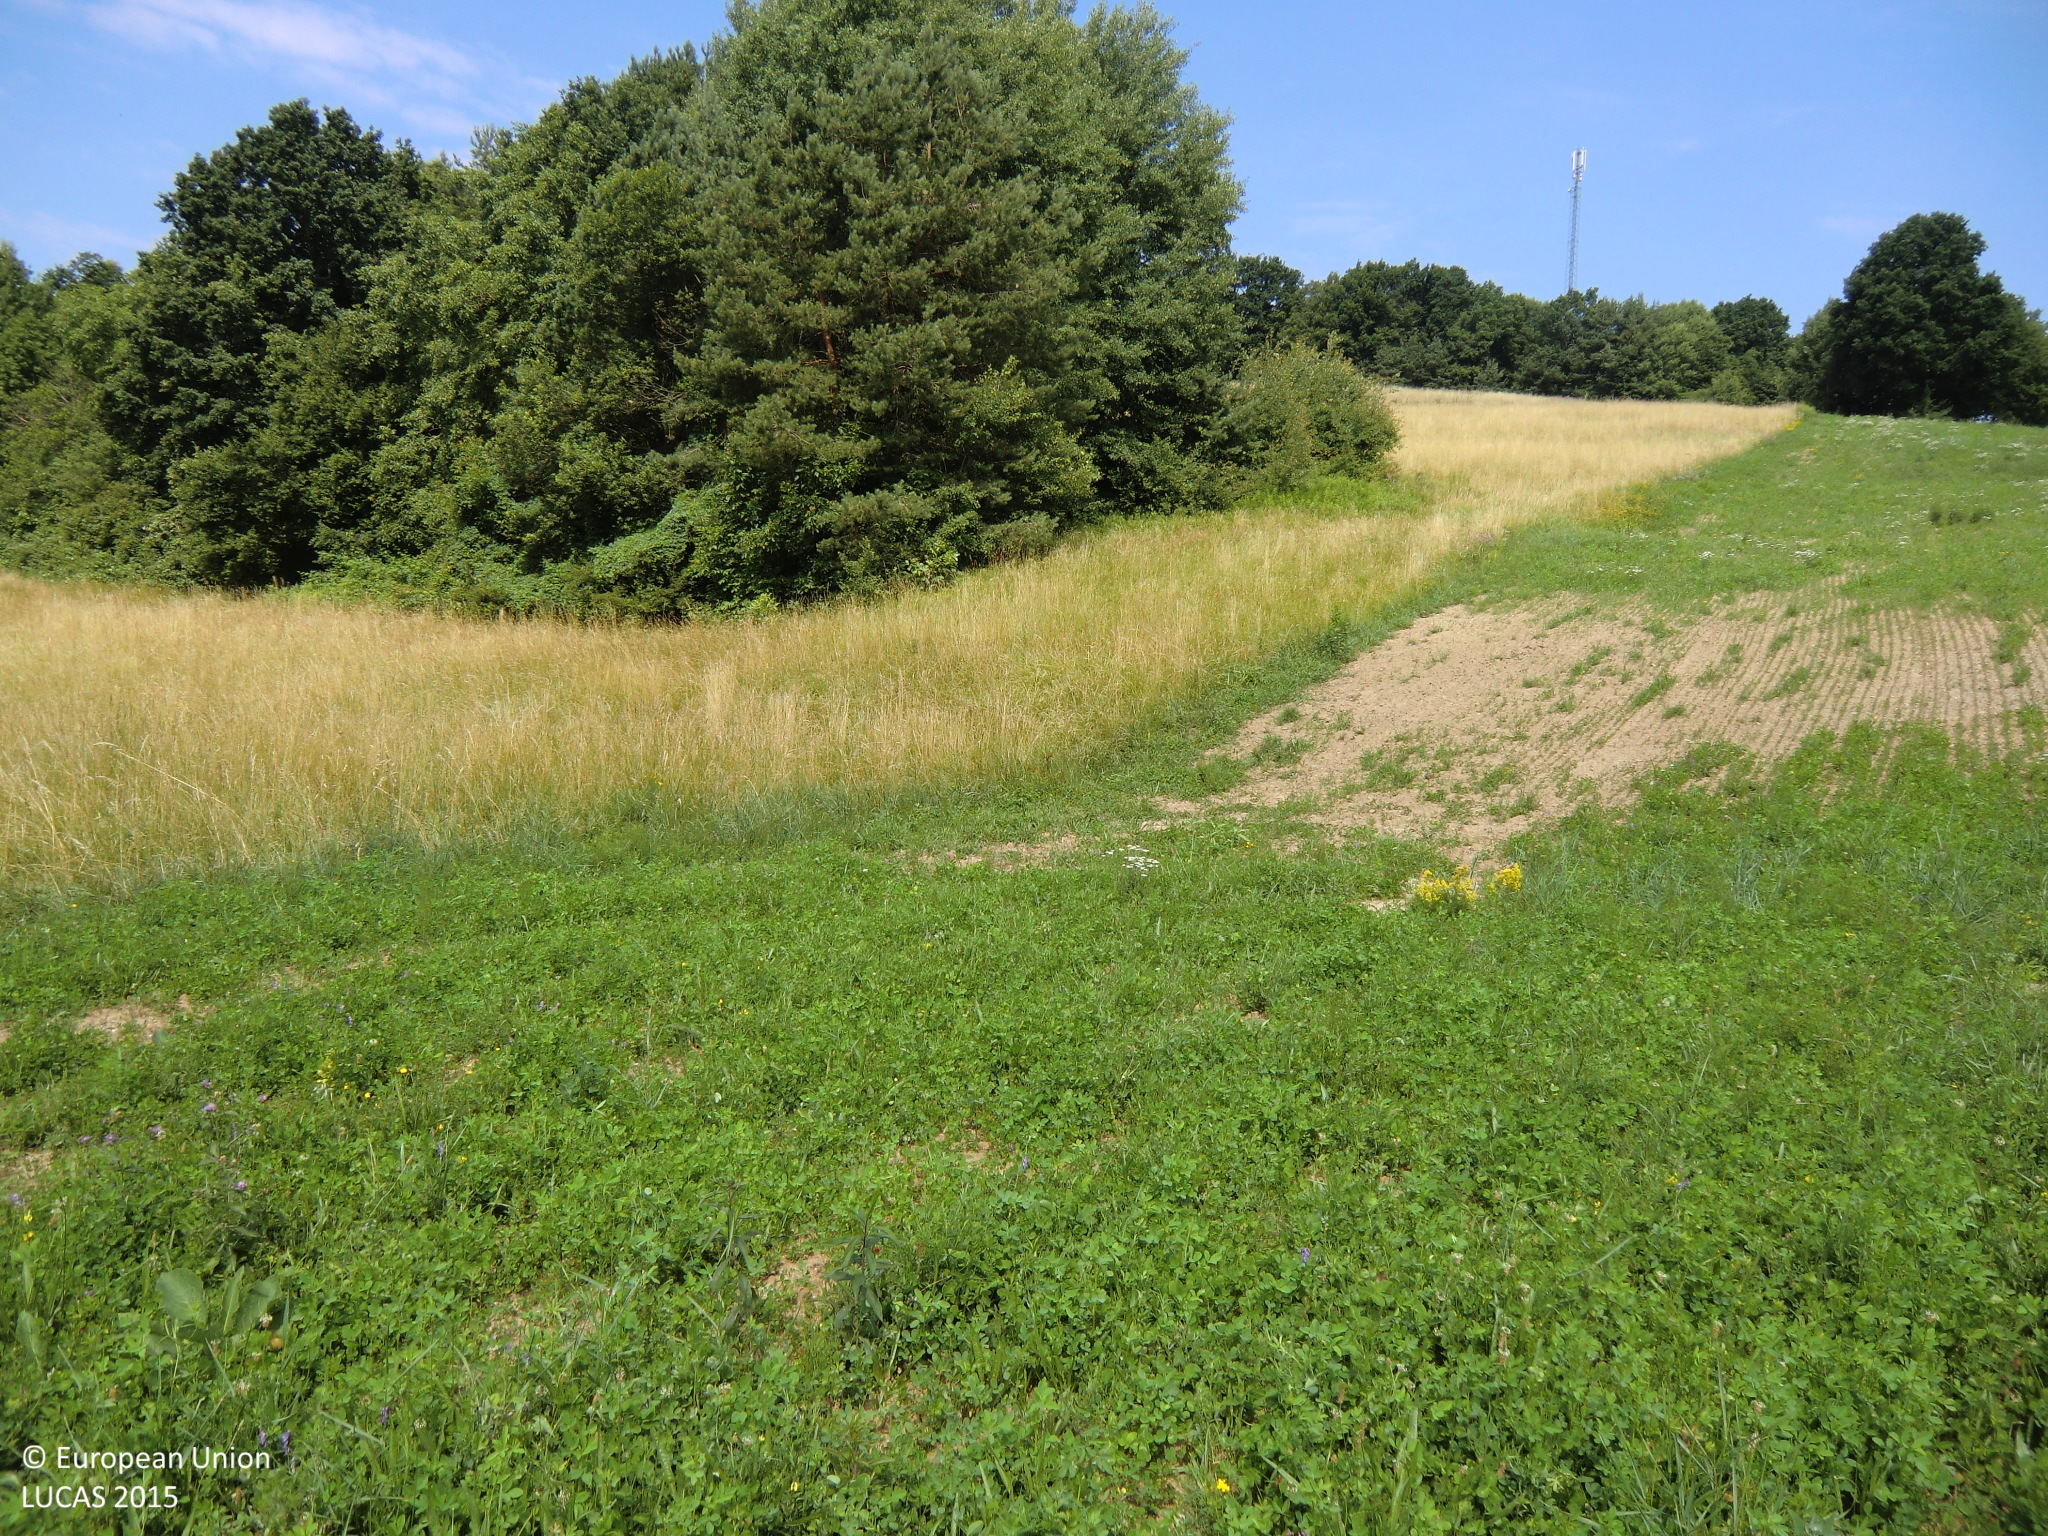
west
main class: Cropland
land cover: Clovers
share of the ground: > 75 %
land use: Agriculture (excluding fallow land and kitchen gardens)
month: July
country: AT
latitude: 47.0949
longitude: 16.1541
